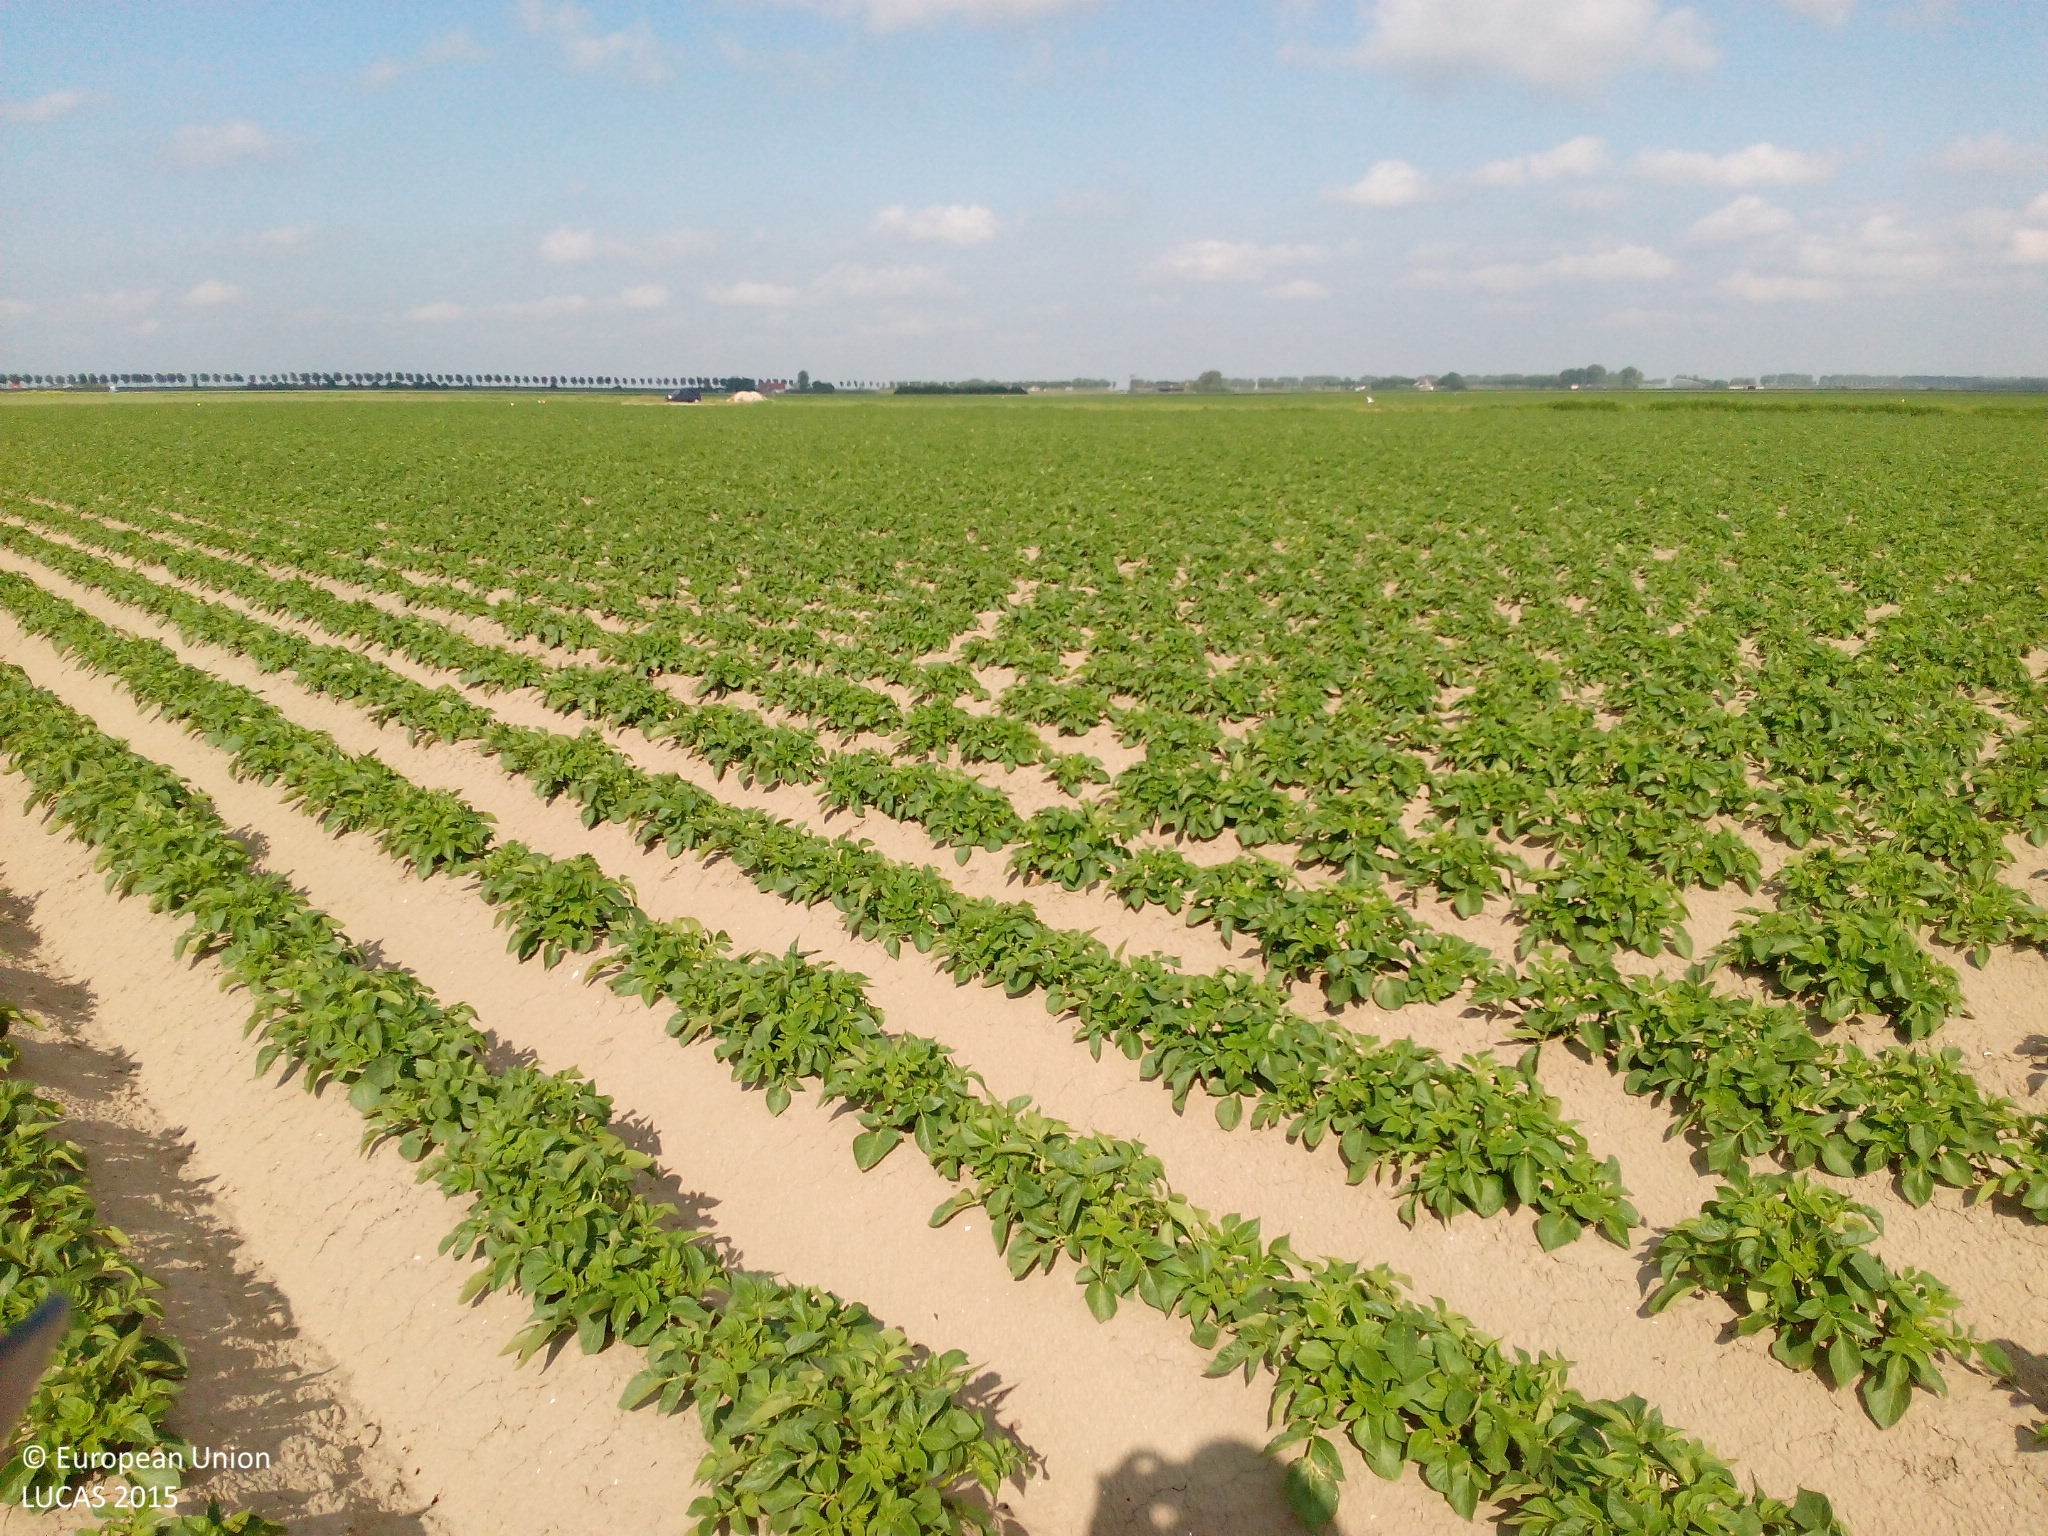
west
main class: Cropland
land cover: Potatoes
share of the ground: 50 - 75 %
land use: Agriculture (excluding fallow land and kitchen gardens)
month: June
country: NL
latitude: 51.7262
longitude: 4.1022
